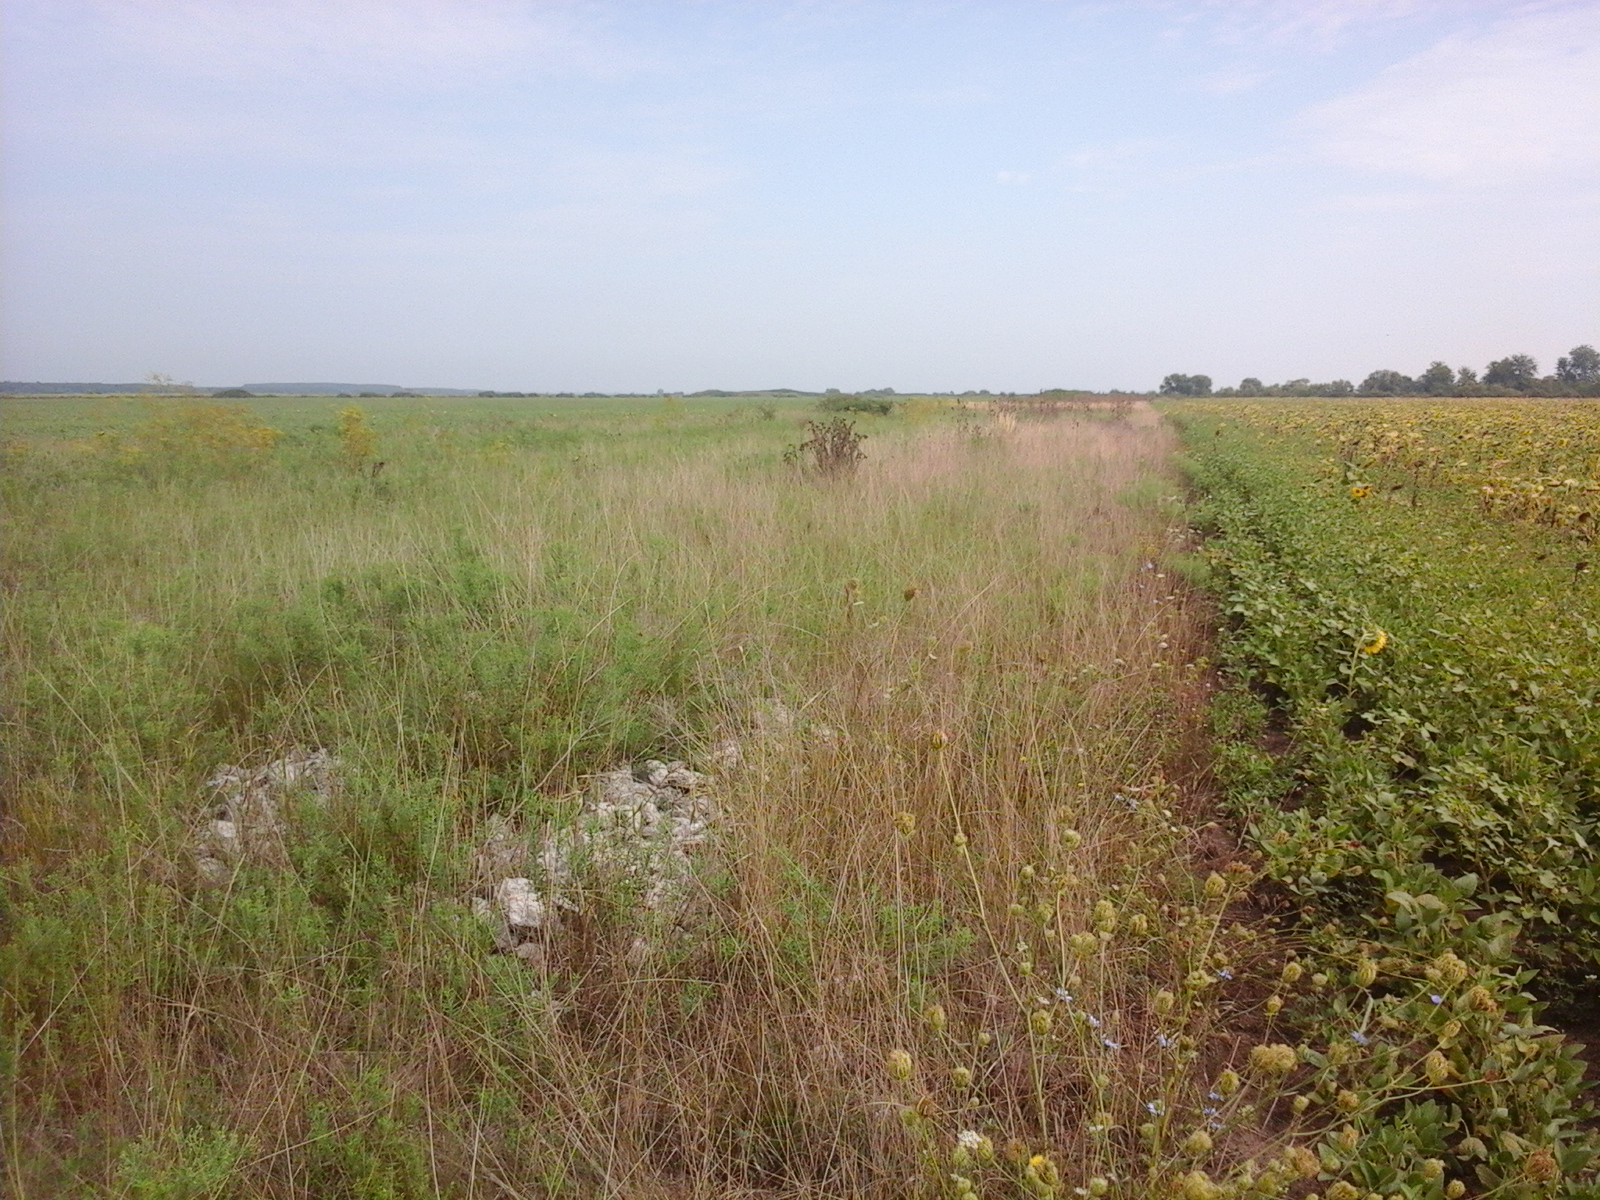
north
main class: Cropland
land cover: Soya
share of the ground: > 75 %
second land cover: Sunflower
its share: > 75 %
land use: Agriculture (excluding fallow land and kitchen gardens)
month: August
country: RO
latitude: 46.7805
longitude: 21.5263
